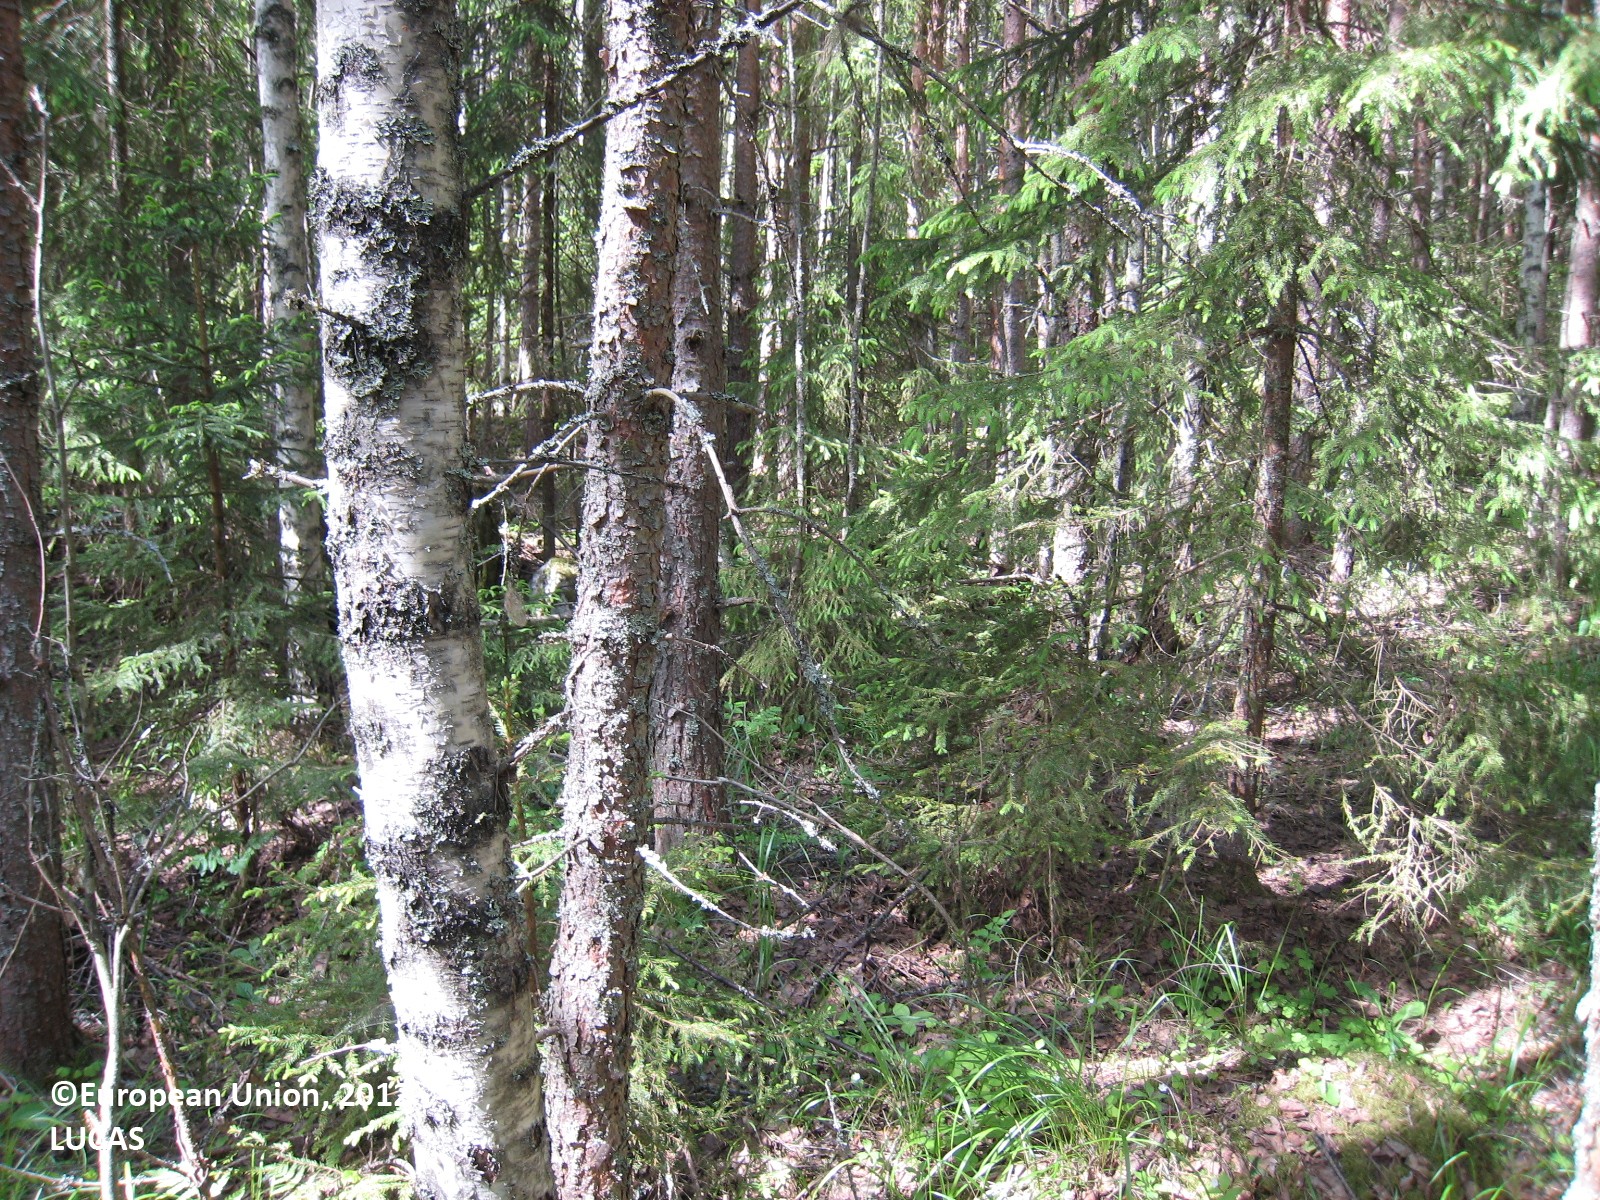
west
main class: Woodland
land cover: Other mixed woodland
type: boreal forest
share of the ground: > 75 %
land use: Forestry
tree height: > 5 m
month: June
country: FI
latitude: 62.0874
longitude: 25.7668
